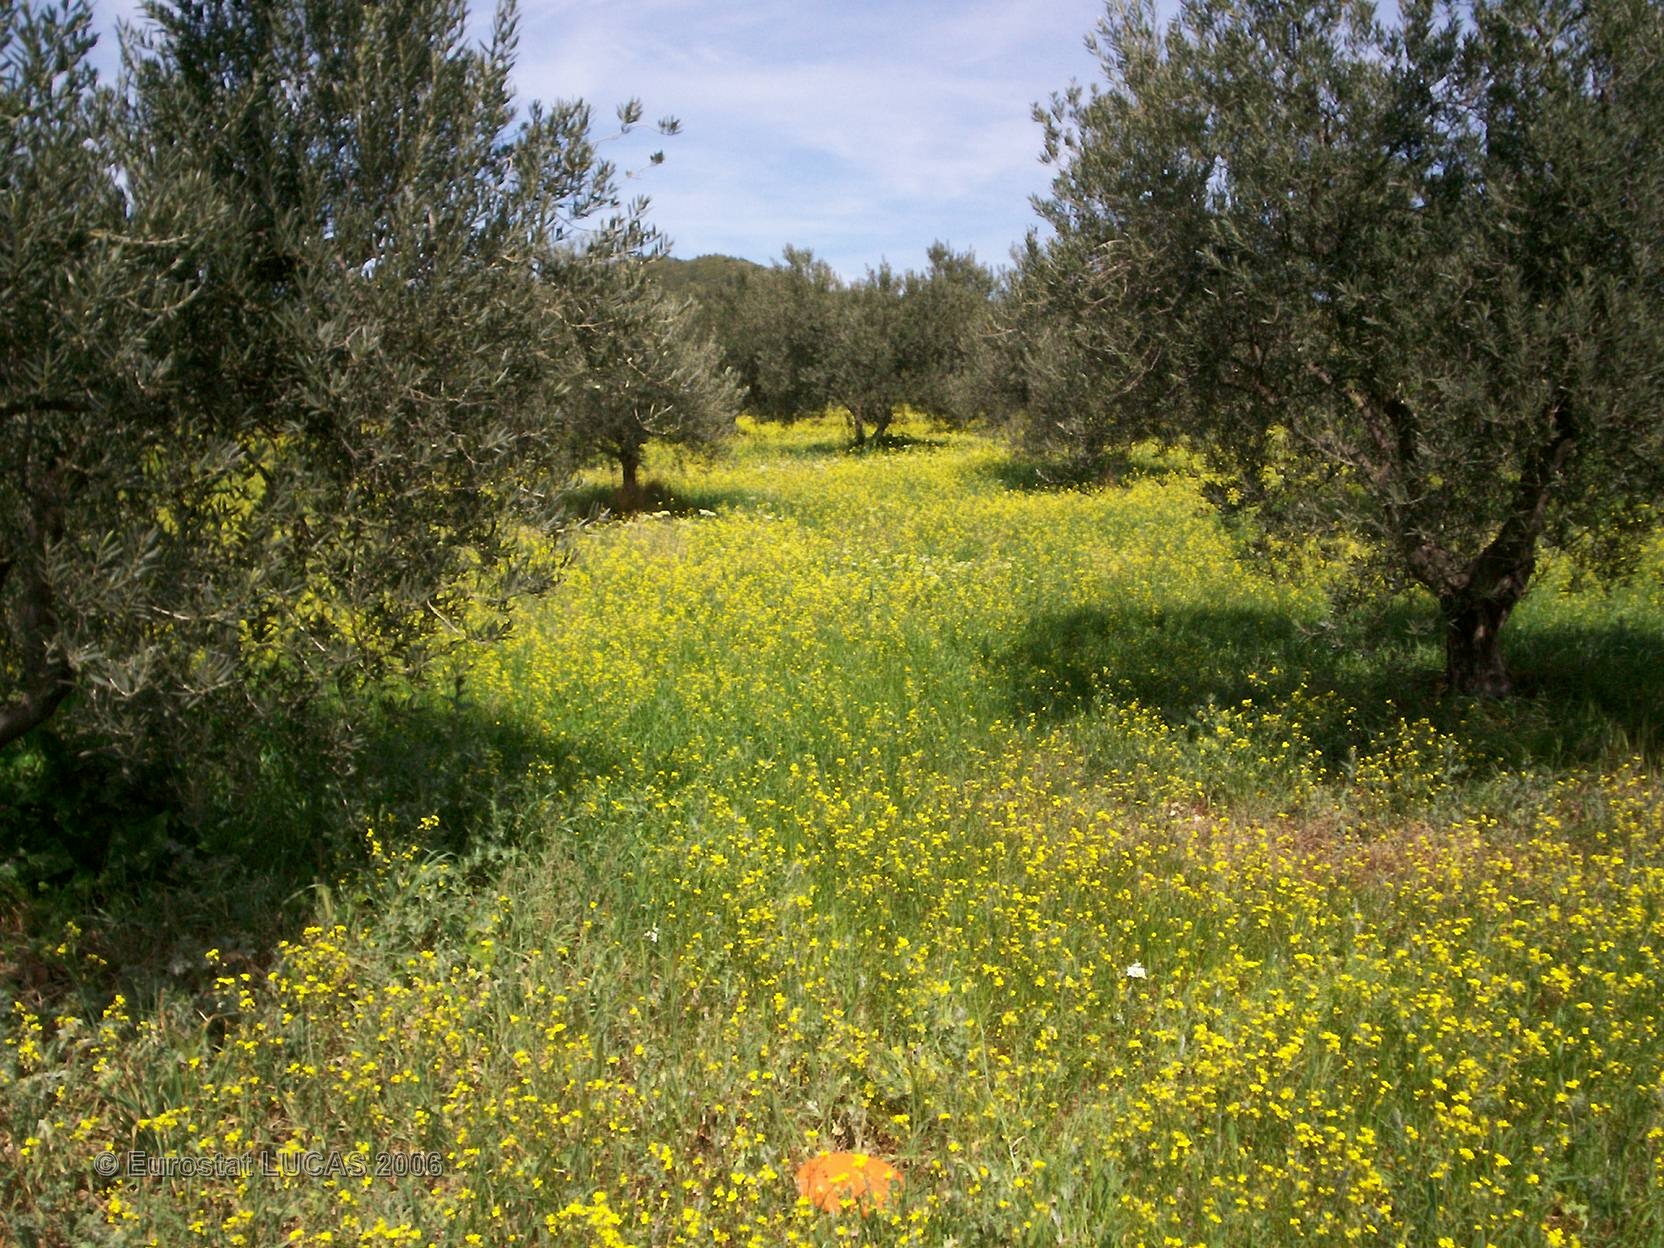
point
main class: Cropland
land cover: Olive groves
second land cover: Grassland with sparse tree/shrub cover
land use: Agriculture (excluding fallow land and kitchen gardens)
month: April
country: FR
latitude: 43.7027
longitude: 4.9340
